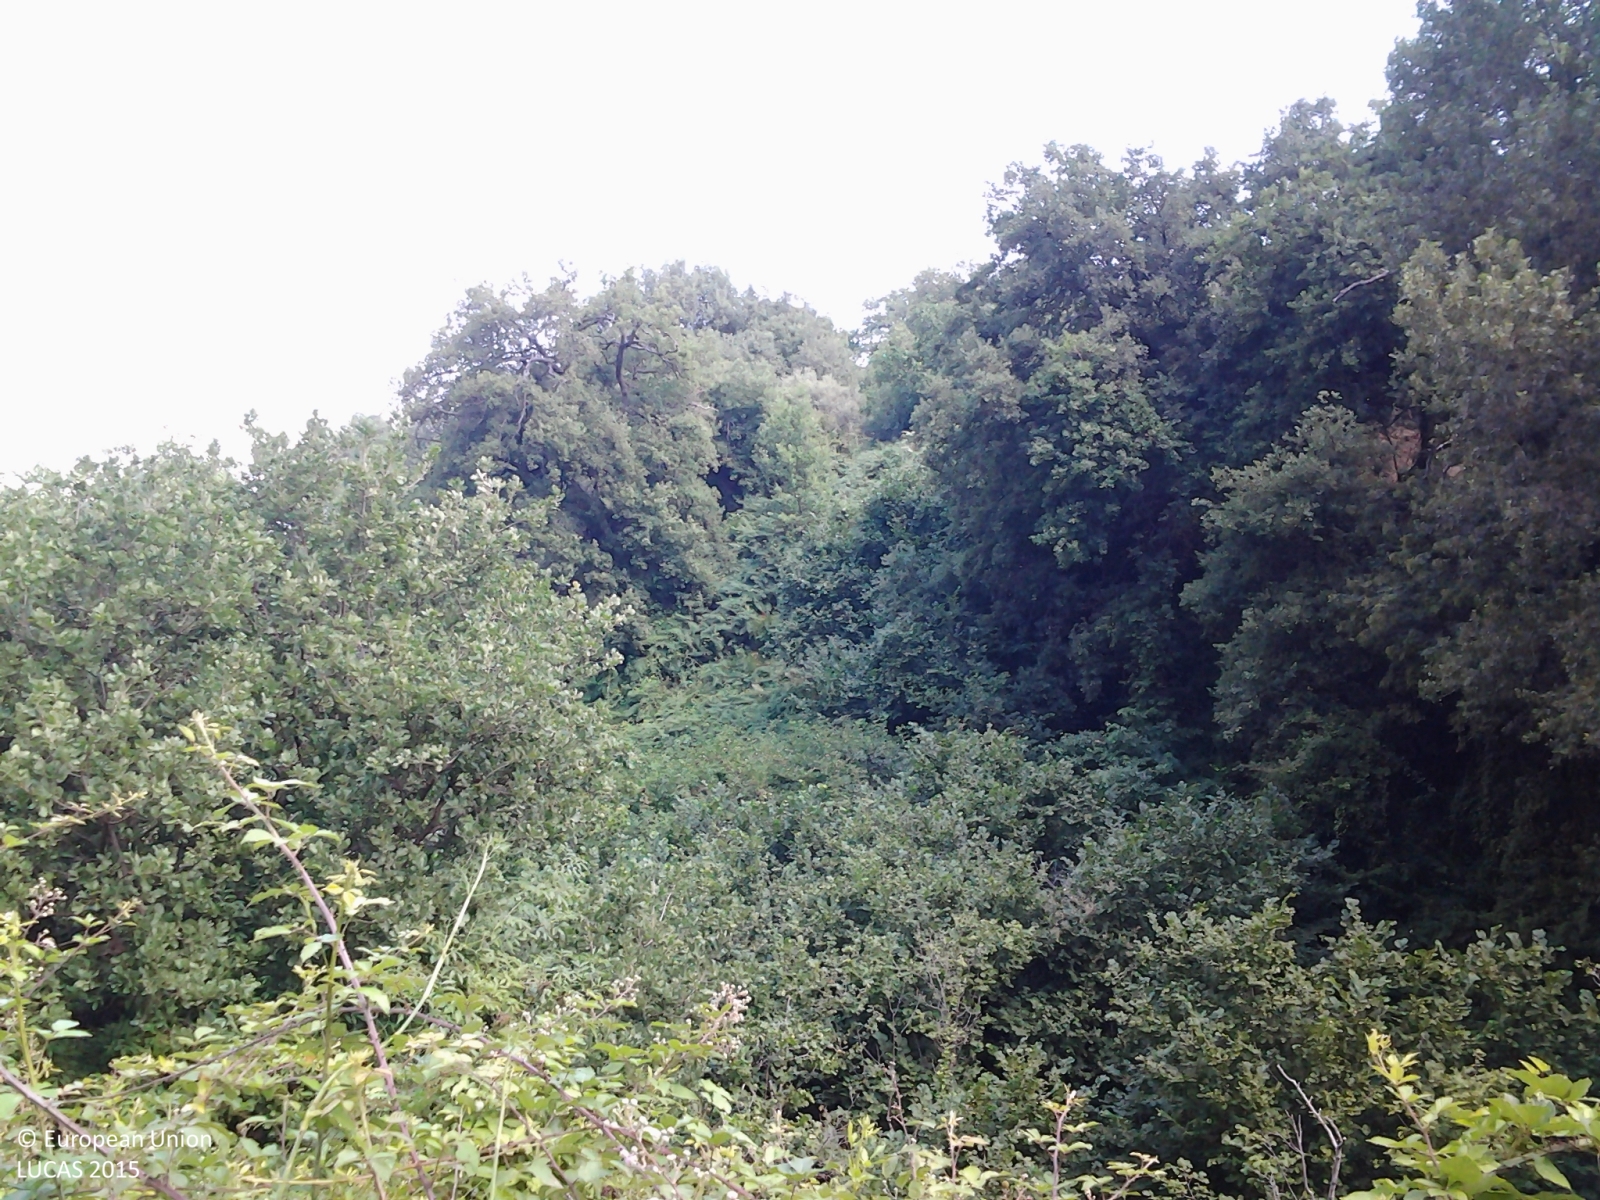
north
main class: Shrubland
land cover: Shrubland with sparse tree cover
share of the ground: > 75 %
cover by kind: shrubs 85 %, broadleaved forest trees 5 %, herbaceous plants 5 %
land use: Semi-natural and natural areas not in use
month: July
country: IT
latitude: 38.1298
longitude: 14.9075
